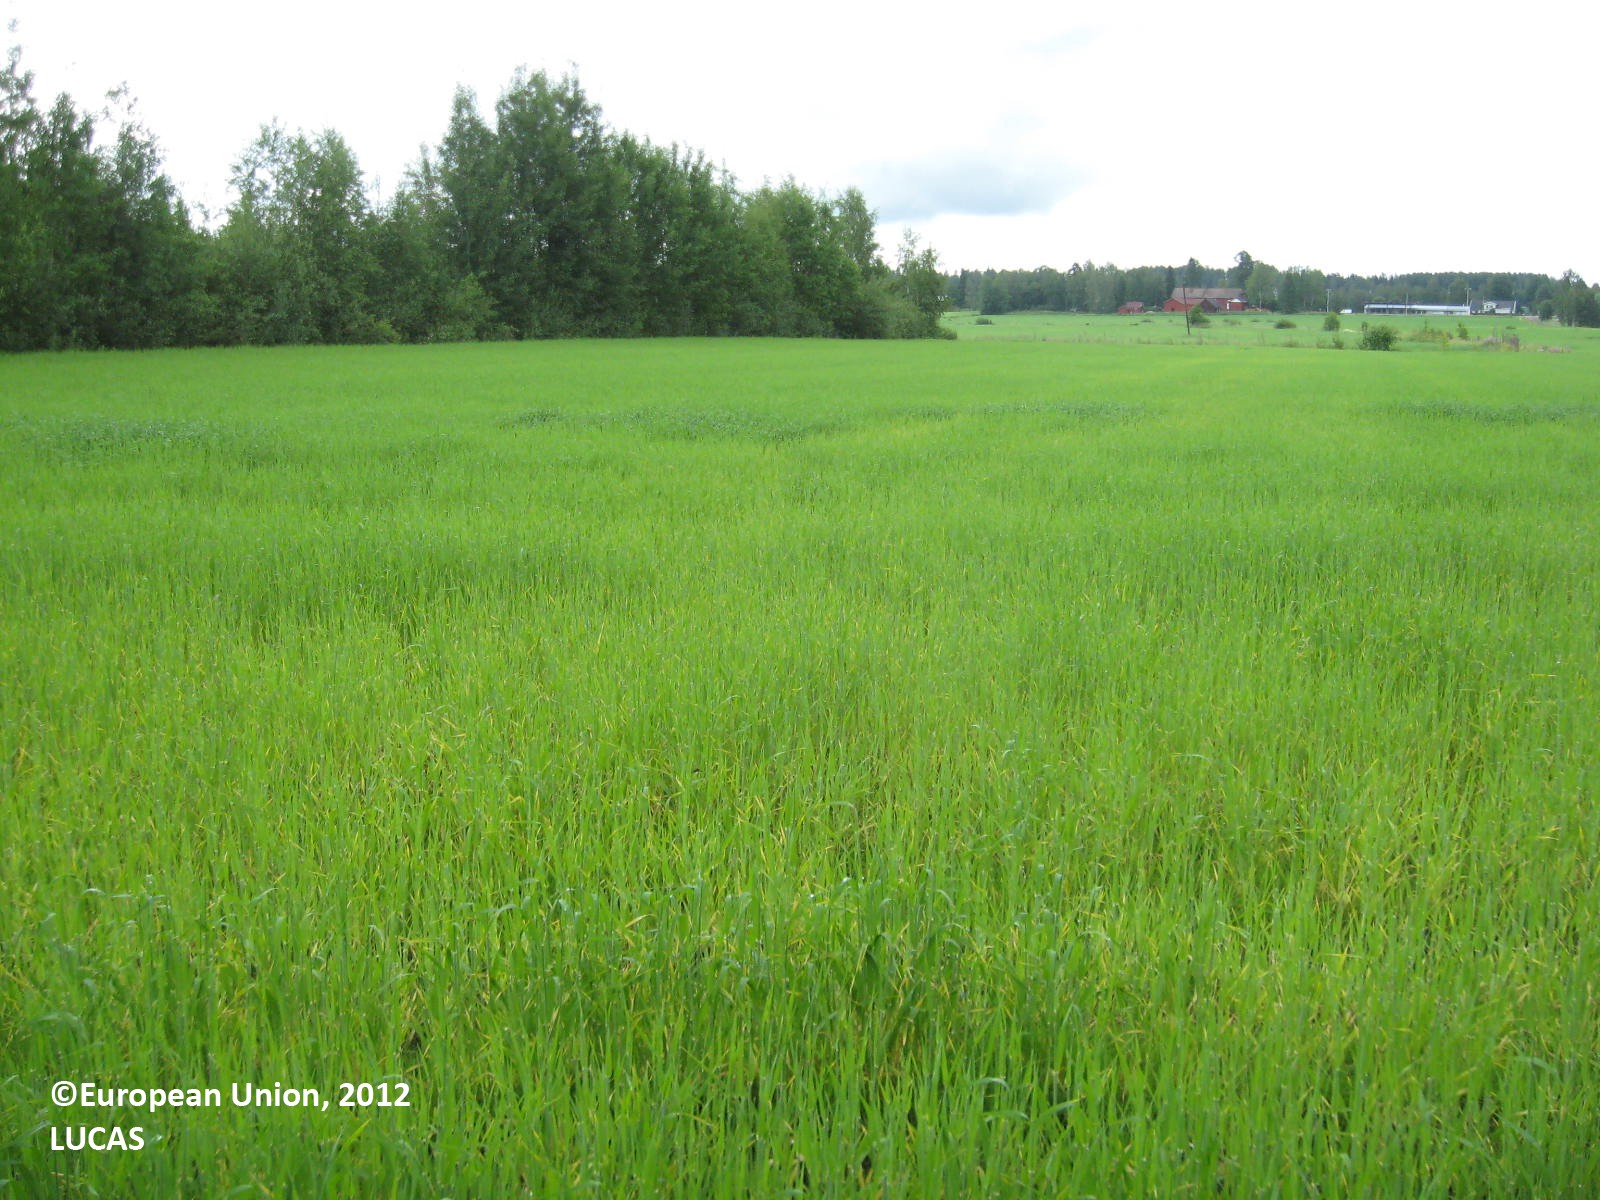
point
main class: Cropland
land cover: Barley
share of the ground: > 75 %
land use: Agriculture (excluding fallow land and kitchen gardens)
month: July
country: FI
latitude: 62.3536
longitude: 22.8309
